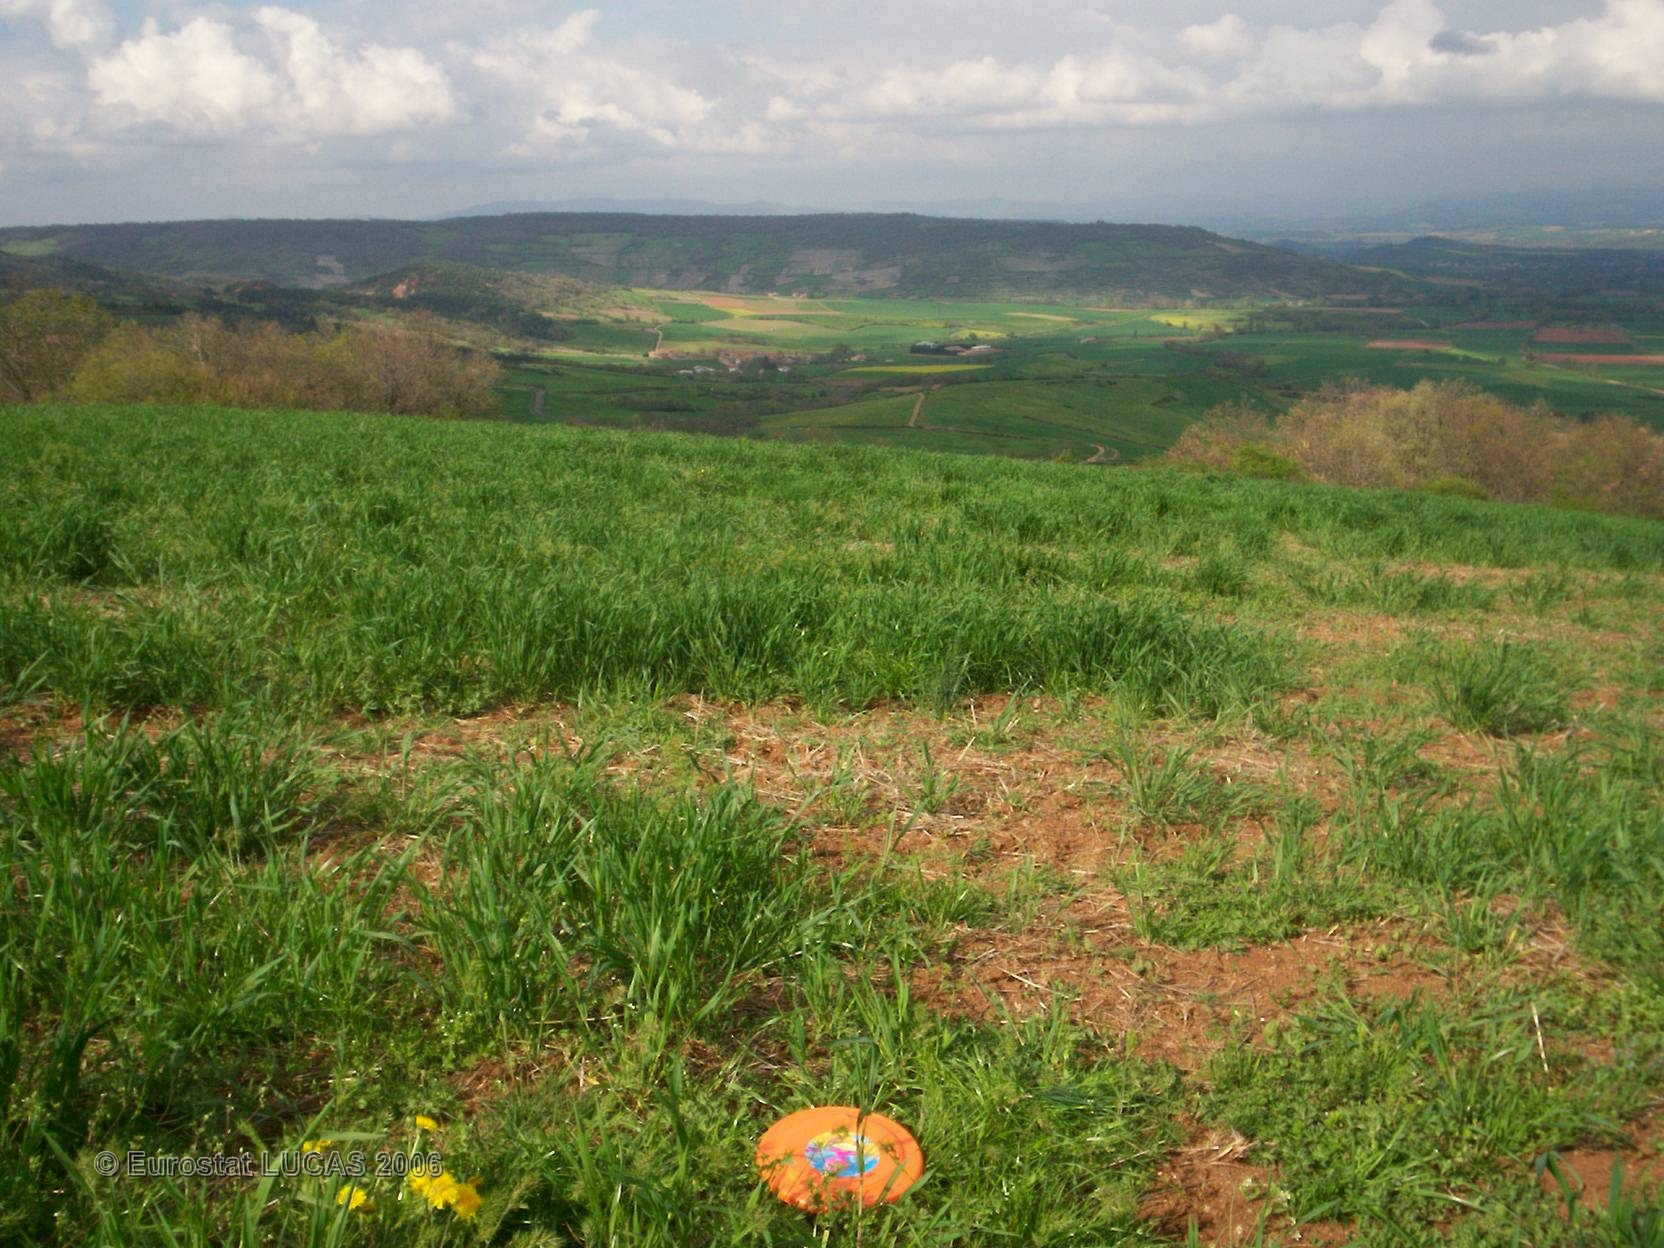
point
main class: Grassland
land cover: Grassland without tree/shrub cover
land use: Agriculture (excluding fallow land and kitchen gardens)
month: April
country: FR
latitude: 45.4273
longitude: 3.1631
